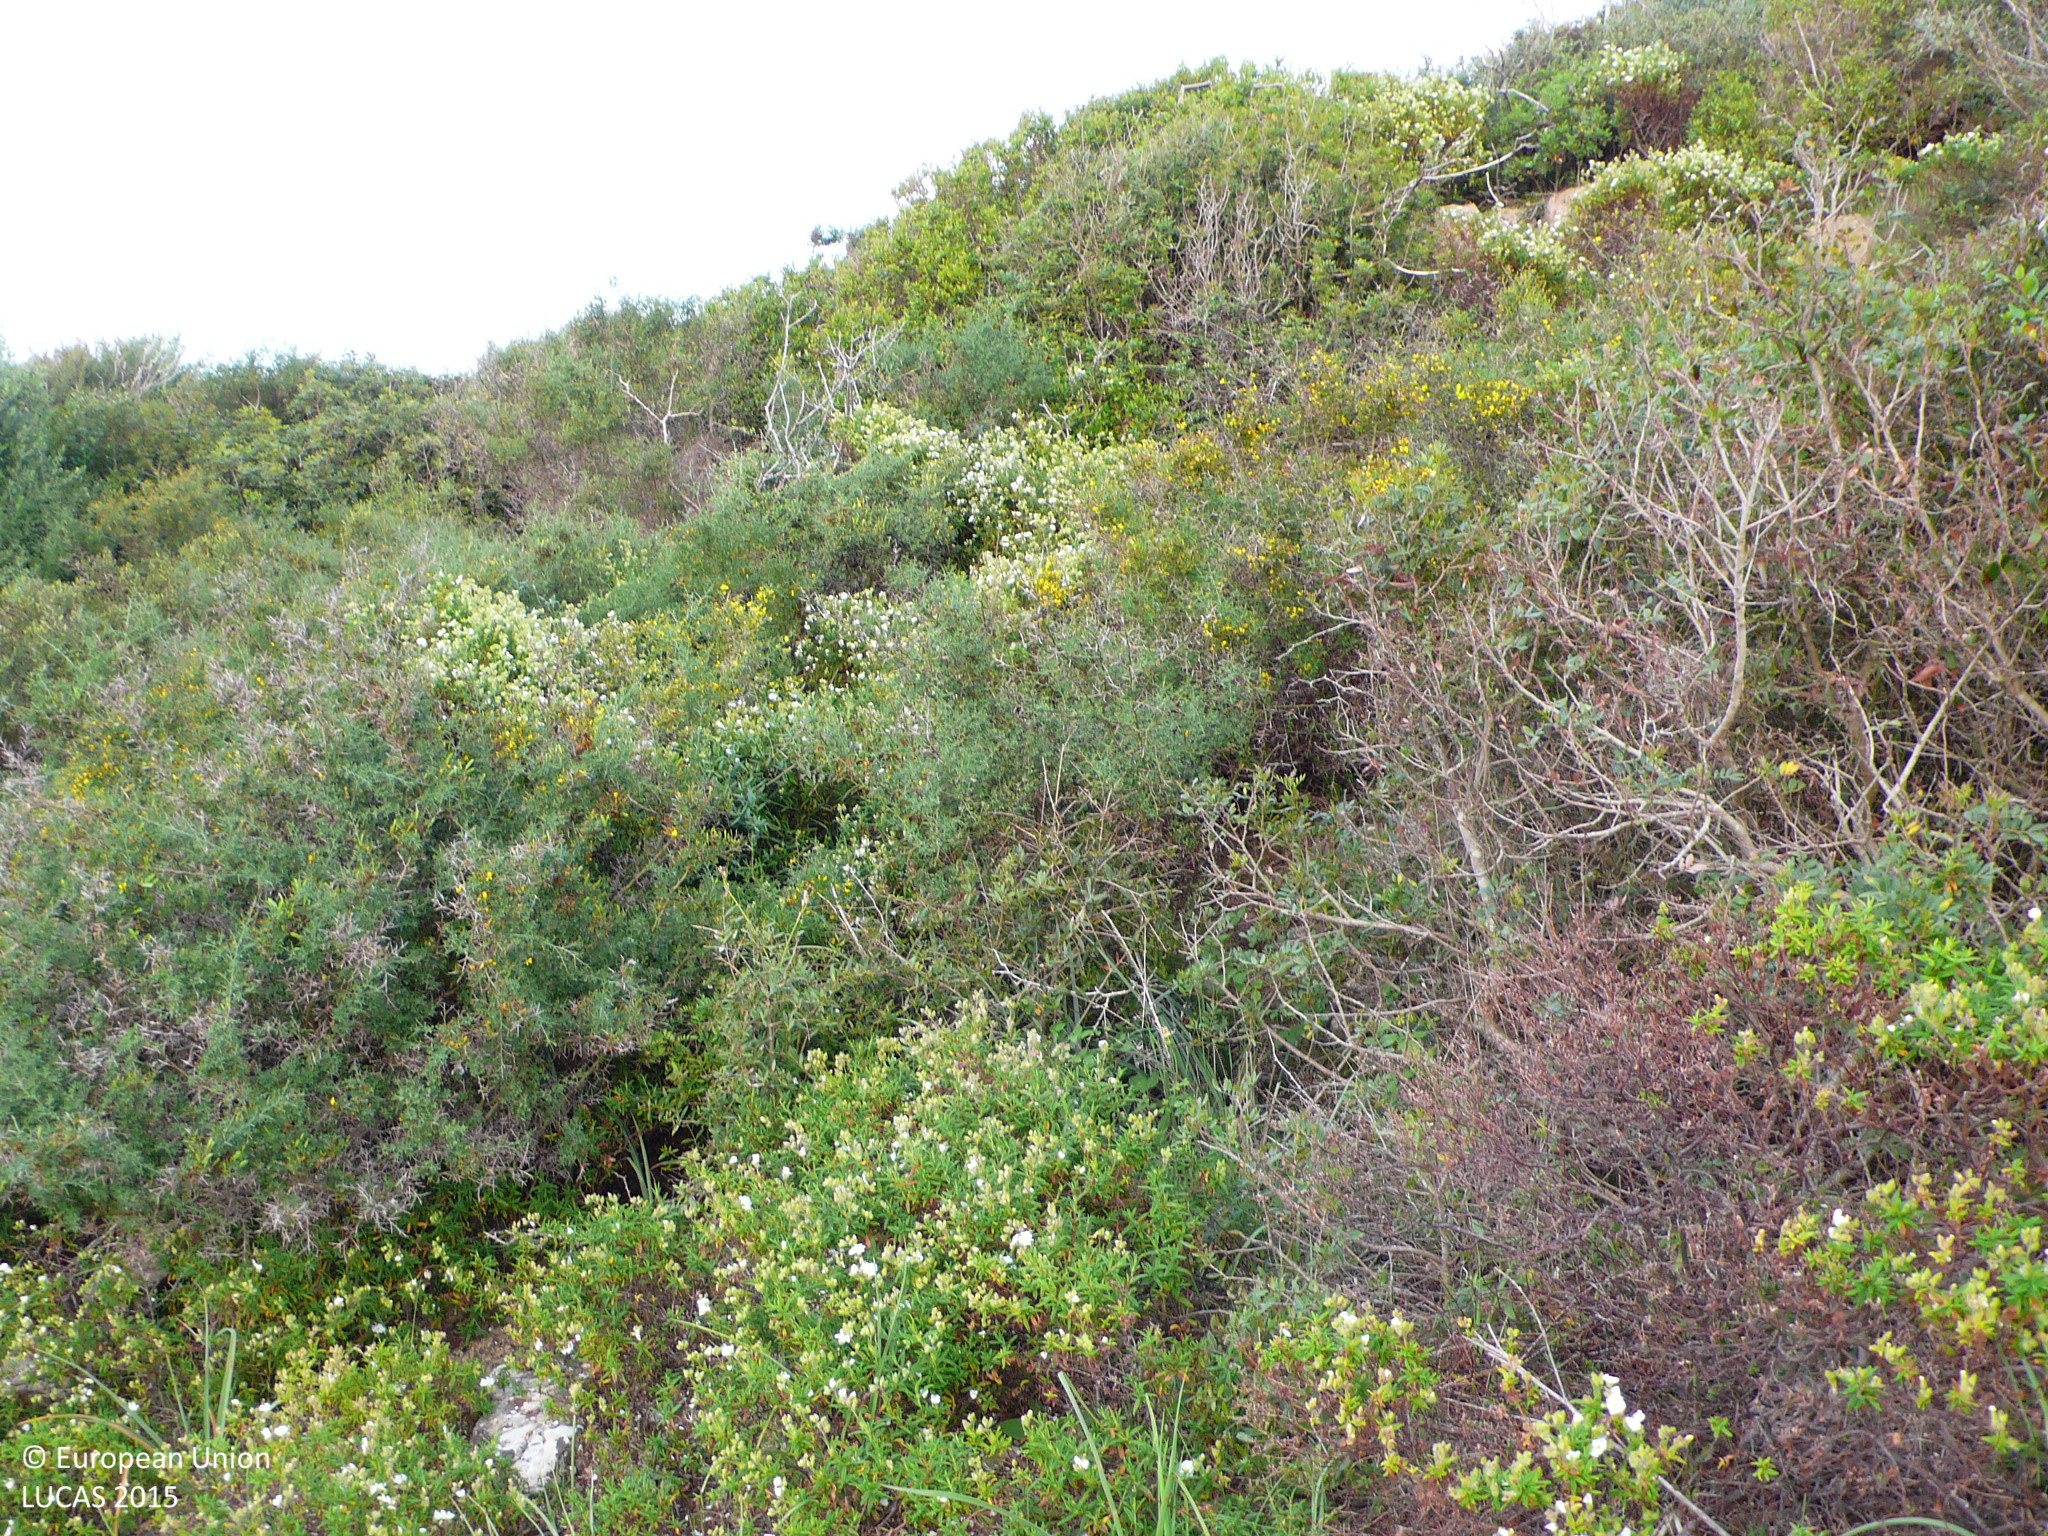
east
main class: Shrubland
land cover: Shrubland without tree cover
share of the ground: 50 - 75 %
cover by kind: shrubs 70 %, herbaceous plants 30 %
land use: Semi-natural and natural areas not in use
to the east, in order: Shrubland without tree cover; Electric lines; Shrubland without tree cover; Grassland with sparse tree/shrub cover; Pine dominated mixed woodland; Grassland with sparse tree/shrub cover; Electric lines; Abandoned hedges; Dry stone walls; Grass margins; Paved roads, cycling and walking lanes; Grass margins; Managed hedges; Pine dominated mixed woodland
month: May
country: ES
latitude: 40.0177
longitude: 4.1090
